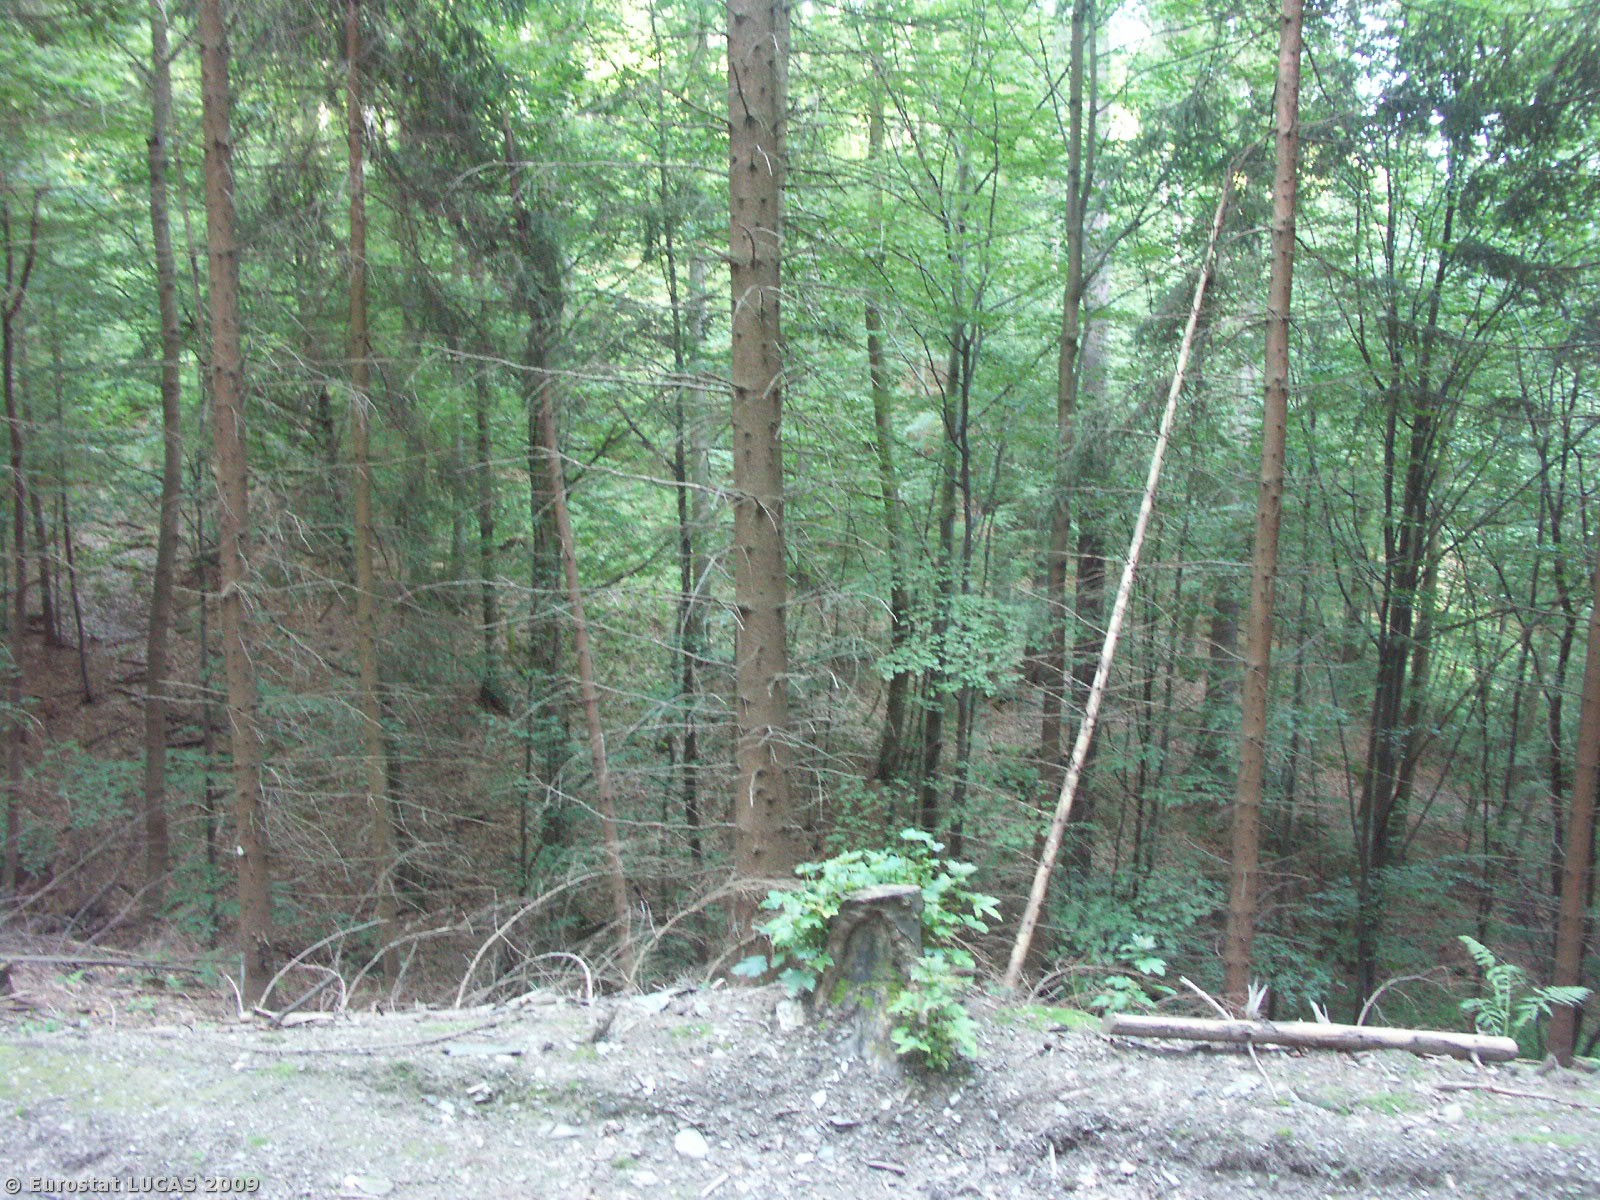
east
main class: Woodland
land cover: Coniferous woodland
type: hemiboreal forest and nemoral coniferous forest and mixed broadleaved-coniferous forest
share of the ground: > 75 %
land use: Forestry
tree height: > 5 m
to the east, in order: Coniferous woodland; Tracks; Mixed woodland; Broadleaved woodland; Rivers and streams; Broadleaved woodland; Mixed woodland; Broadleaved woodland; Coniferous woodland; Broadleaved woodland; Rivers and streams; Broadleaved woodland; Tracks; Broadleaved woodland
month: July
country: CZ
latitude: 49.8821
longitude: 17.2338
